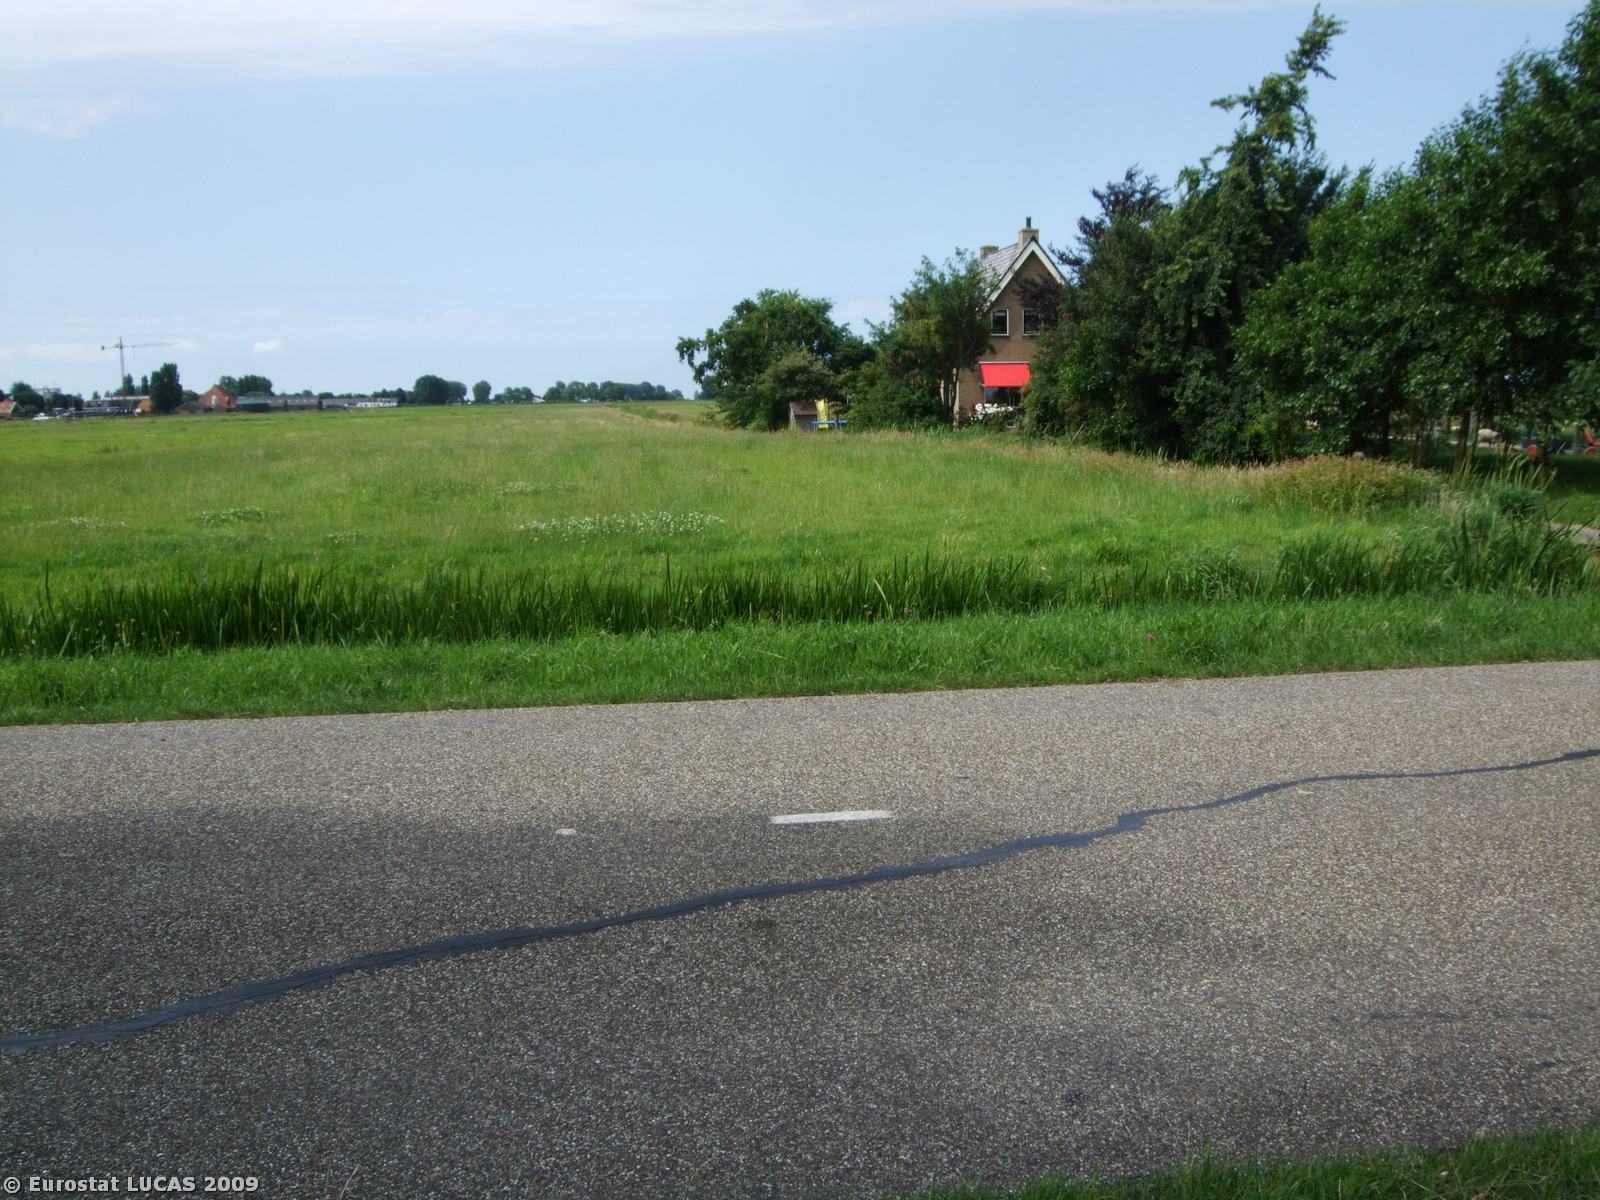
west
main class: Woodland
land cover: Broadleaved woodland
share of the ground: 50 - 75 %
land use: Road transport
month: July
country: NL
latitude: 52.9813
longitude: 5.6349
